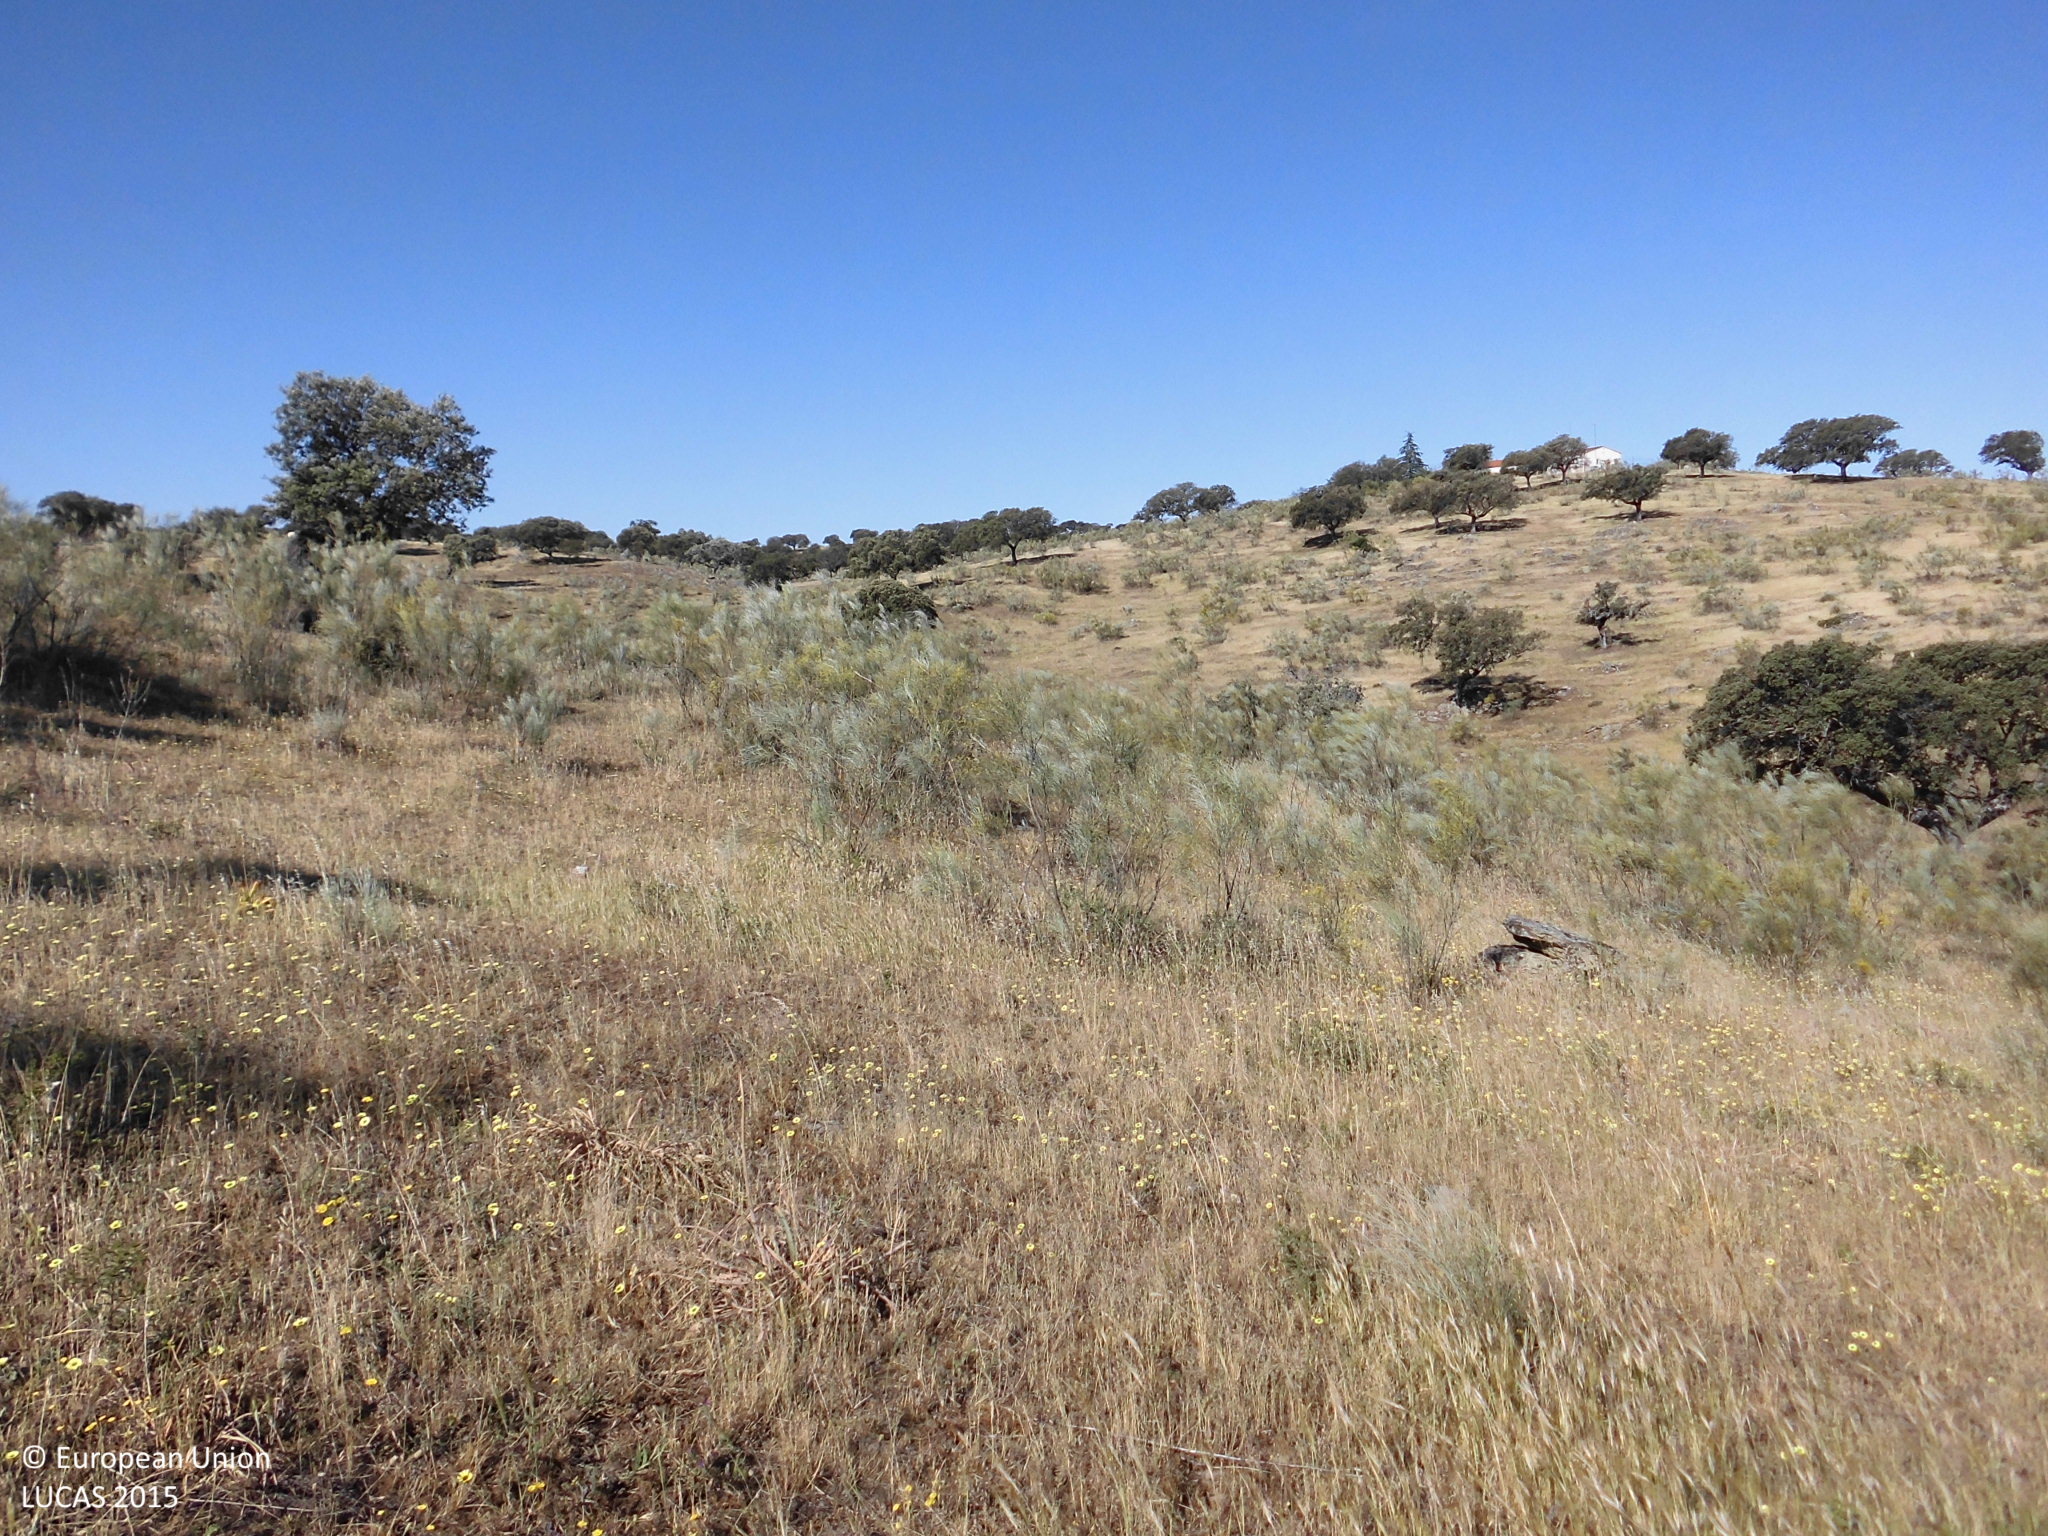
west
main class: Woodland
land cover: Broadleaved woodland
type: broadleaved evergreen forest
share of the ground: 10 - 25 %
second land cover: Grassland without tree/shrub cover
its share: > 75 %
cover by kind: herbaceous plants 65 %, broadleaved forest trees 25 %, shrubs 10 %
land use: Forestry
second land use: Agriculture (excluding fallow land and kitchen gardens)
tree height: > 5 m
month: May
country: ES
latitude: 39.5164
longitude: -6.9587
